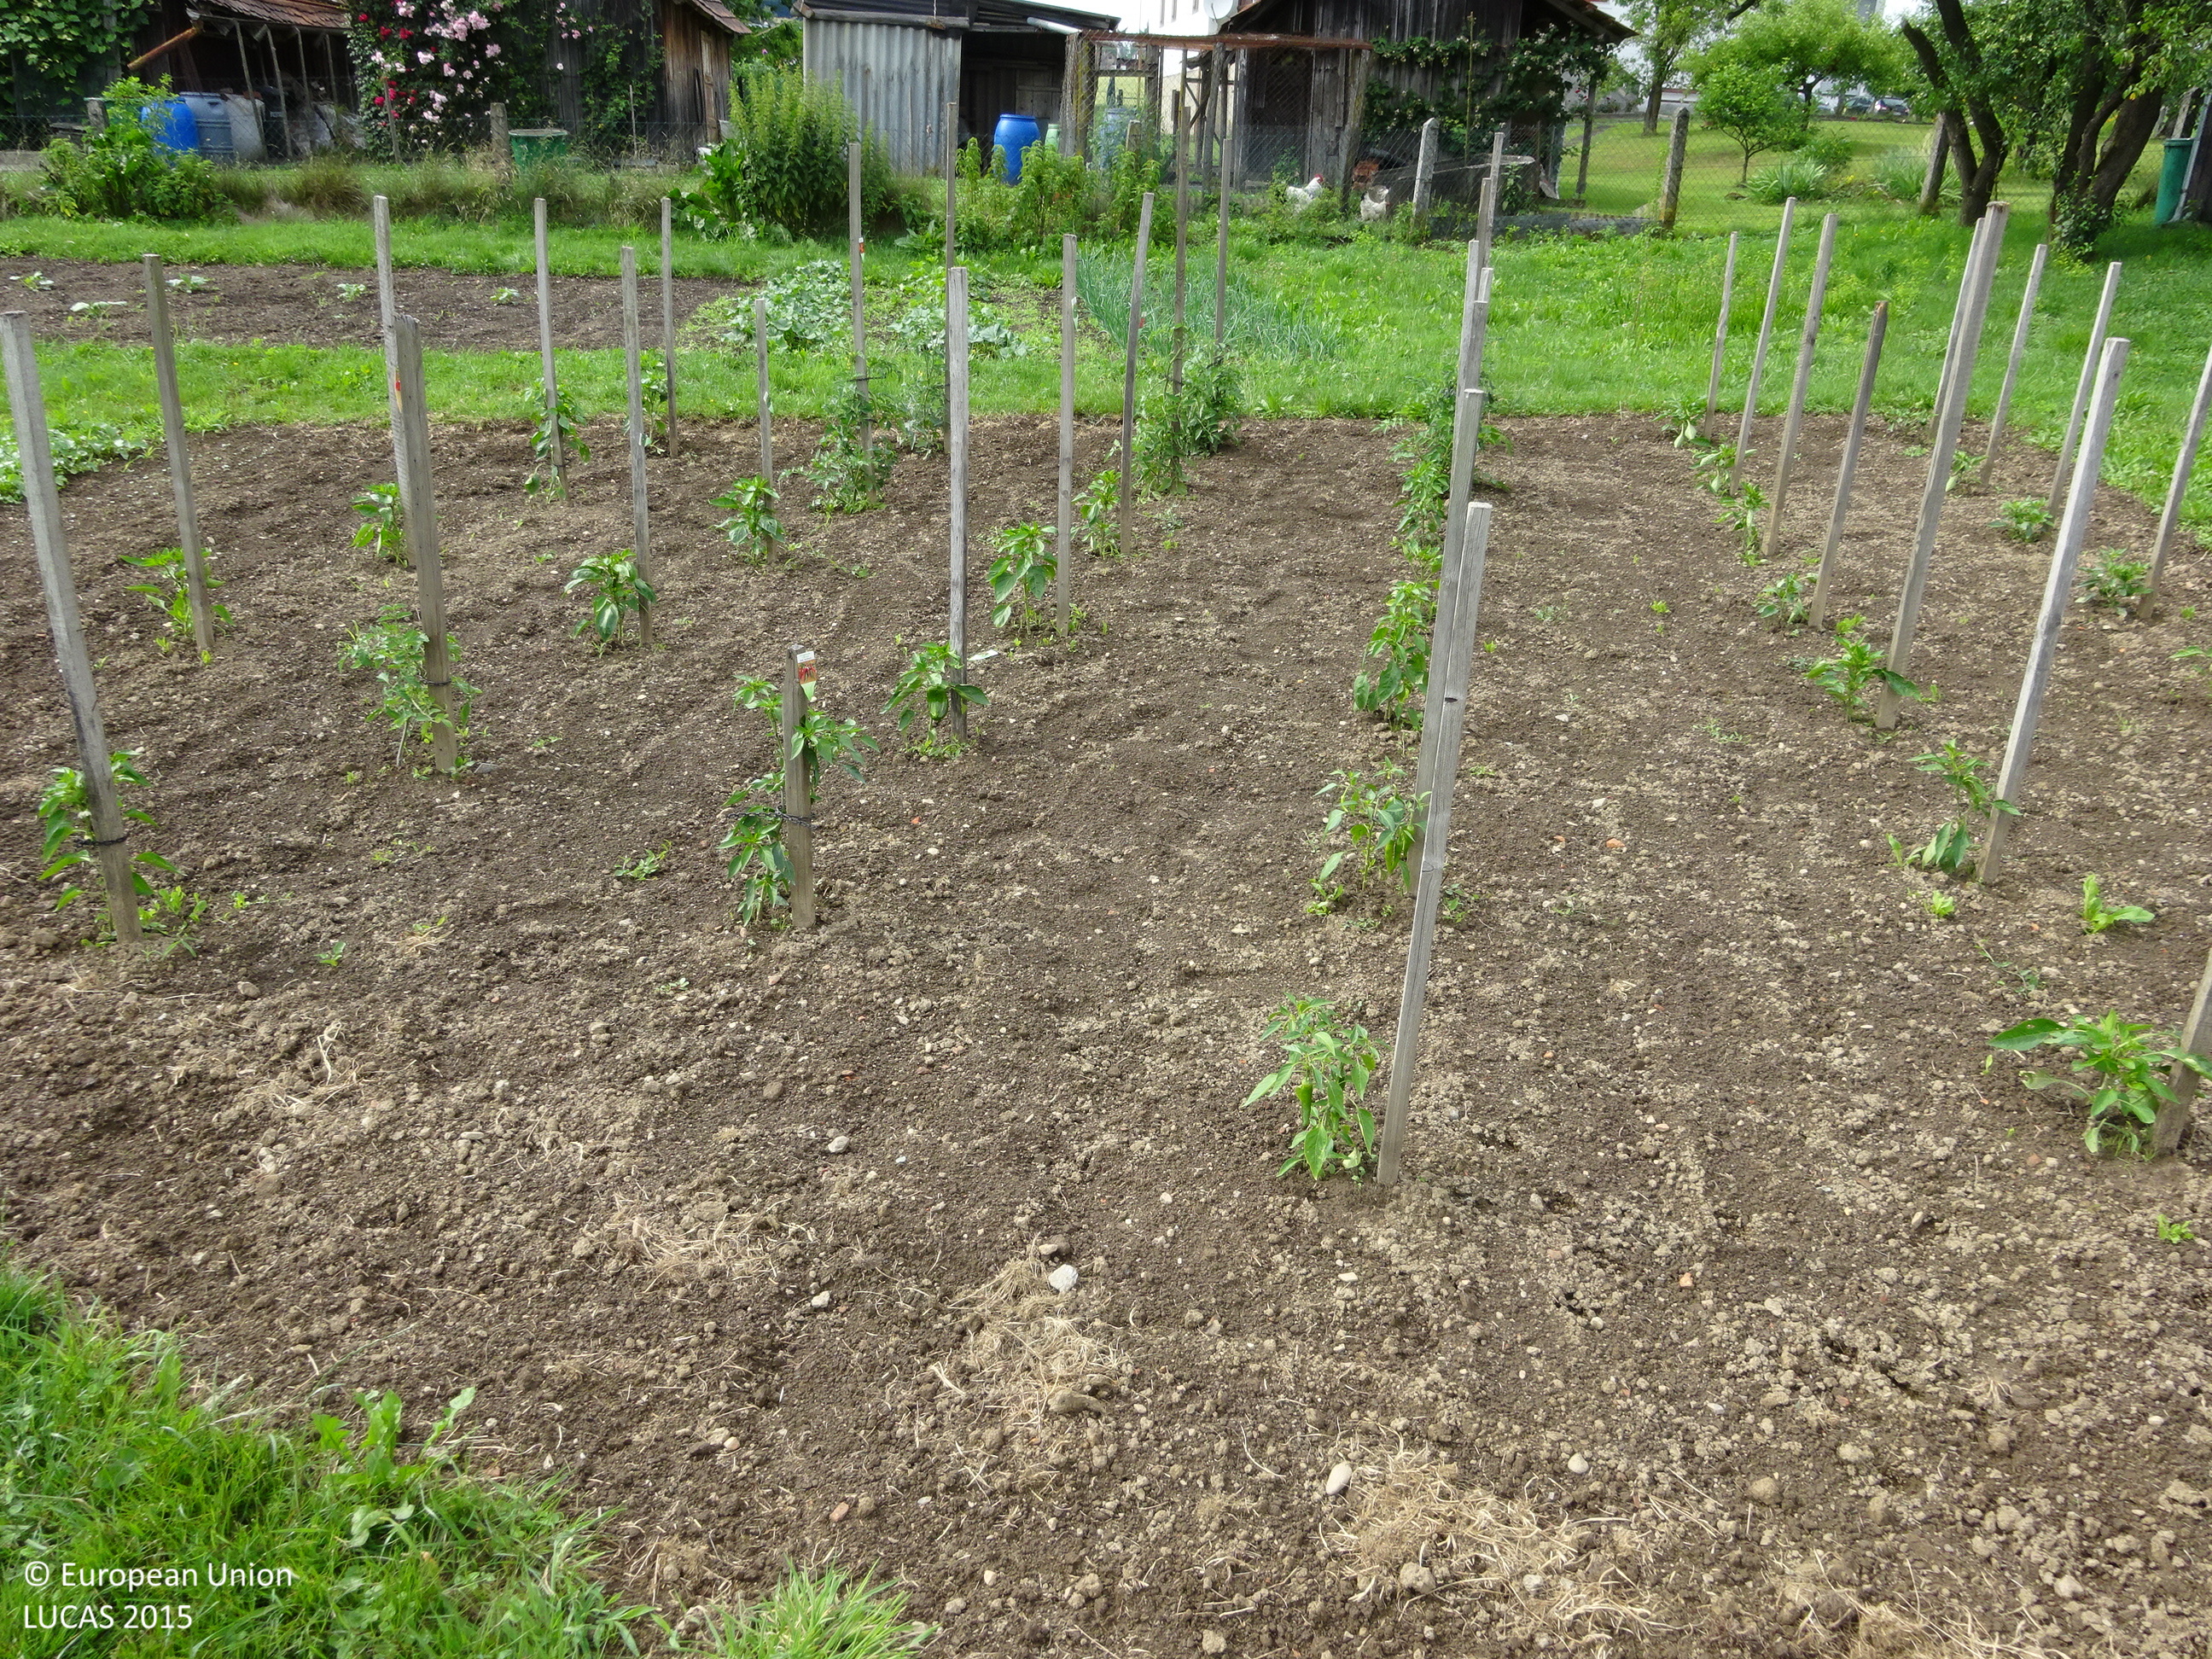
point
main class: Cropland
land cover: Other fresh vegetables
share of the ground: 25 - 50 %
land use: Kitchen garden
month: June
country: AT
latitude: 46.7253
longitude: 15.2980
